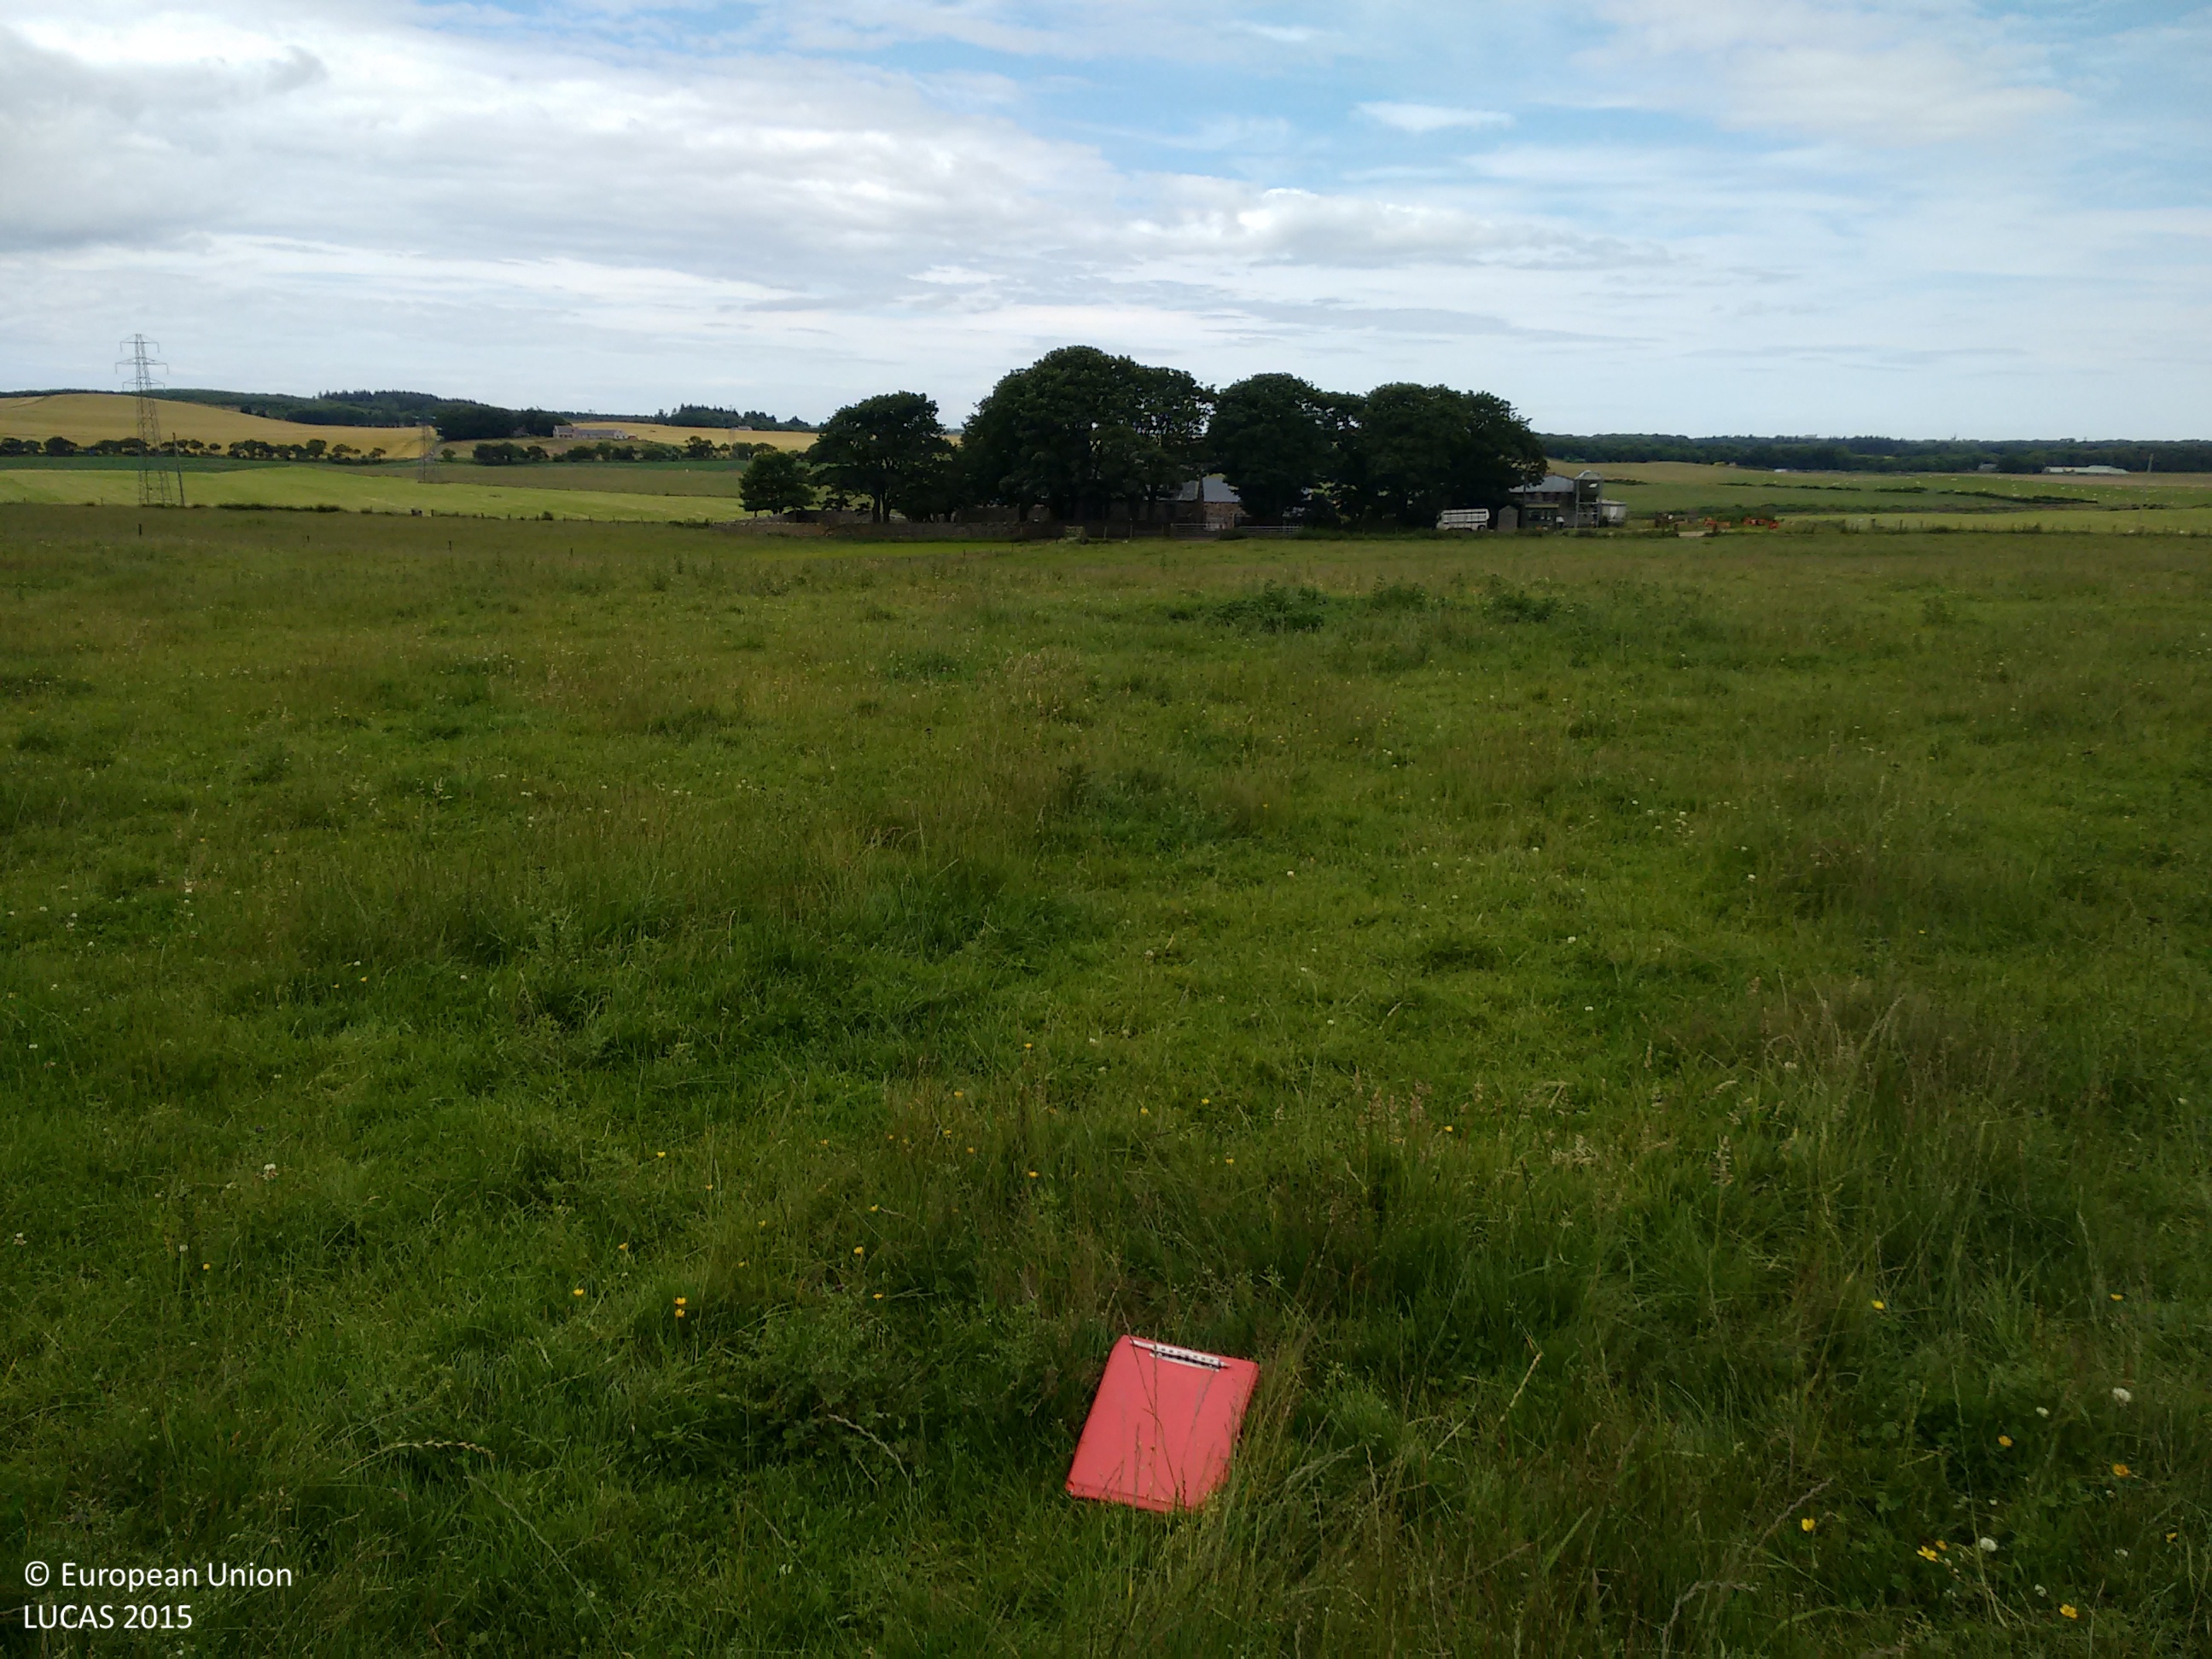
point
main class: Grassland
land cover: Grassland without tree/shrub cover
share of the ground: > 75 %
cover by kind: herbaceous plants 100 %
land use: Agriculture (excluding fallow land and kitchen gardens)
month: July
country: GB
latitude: 57.6441
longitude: -1.9893
